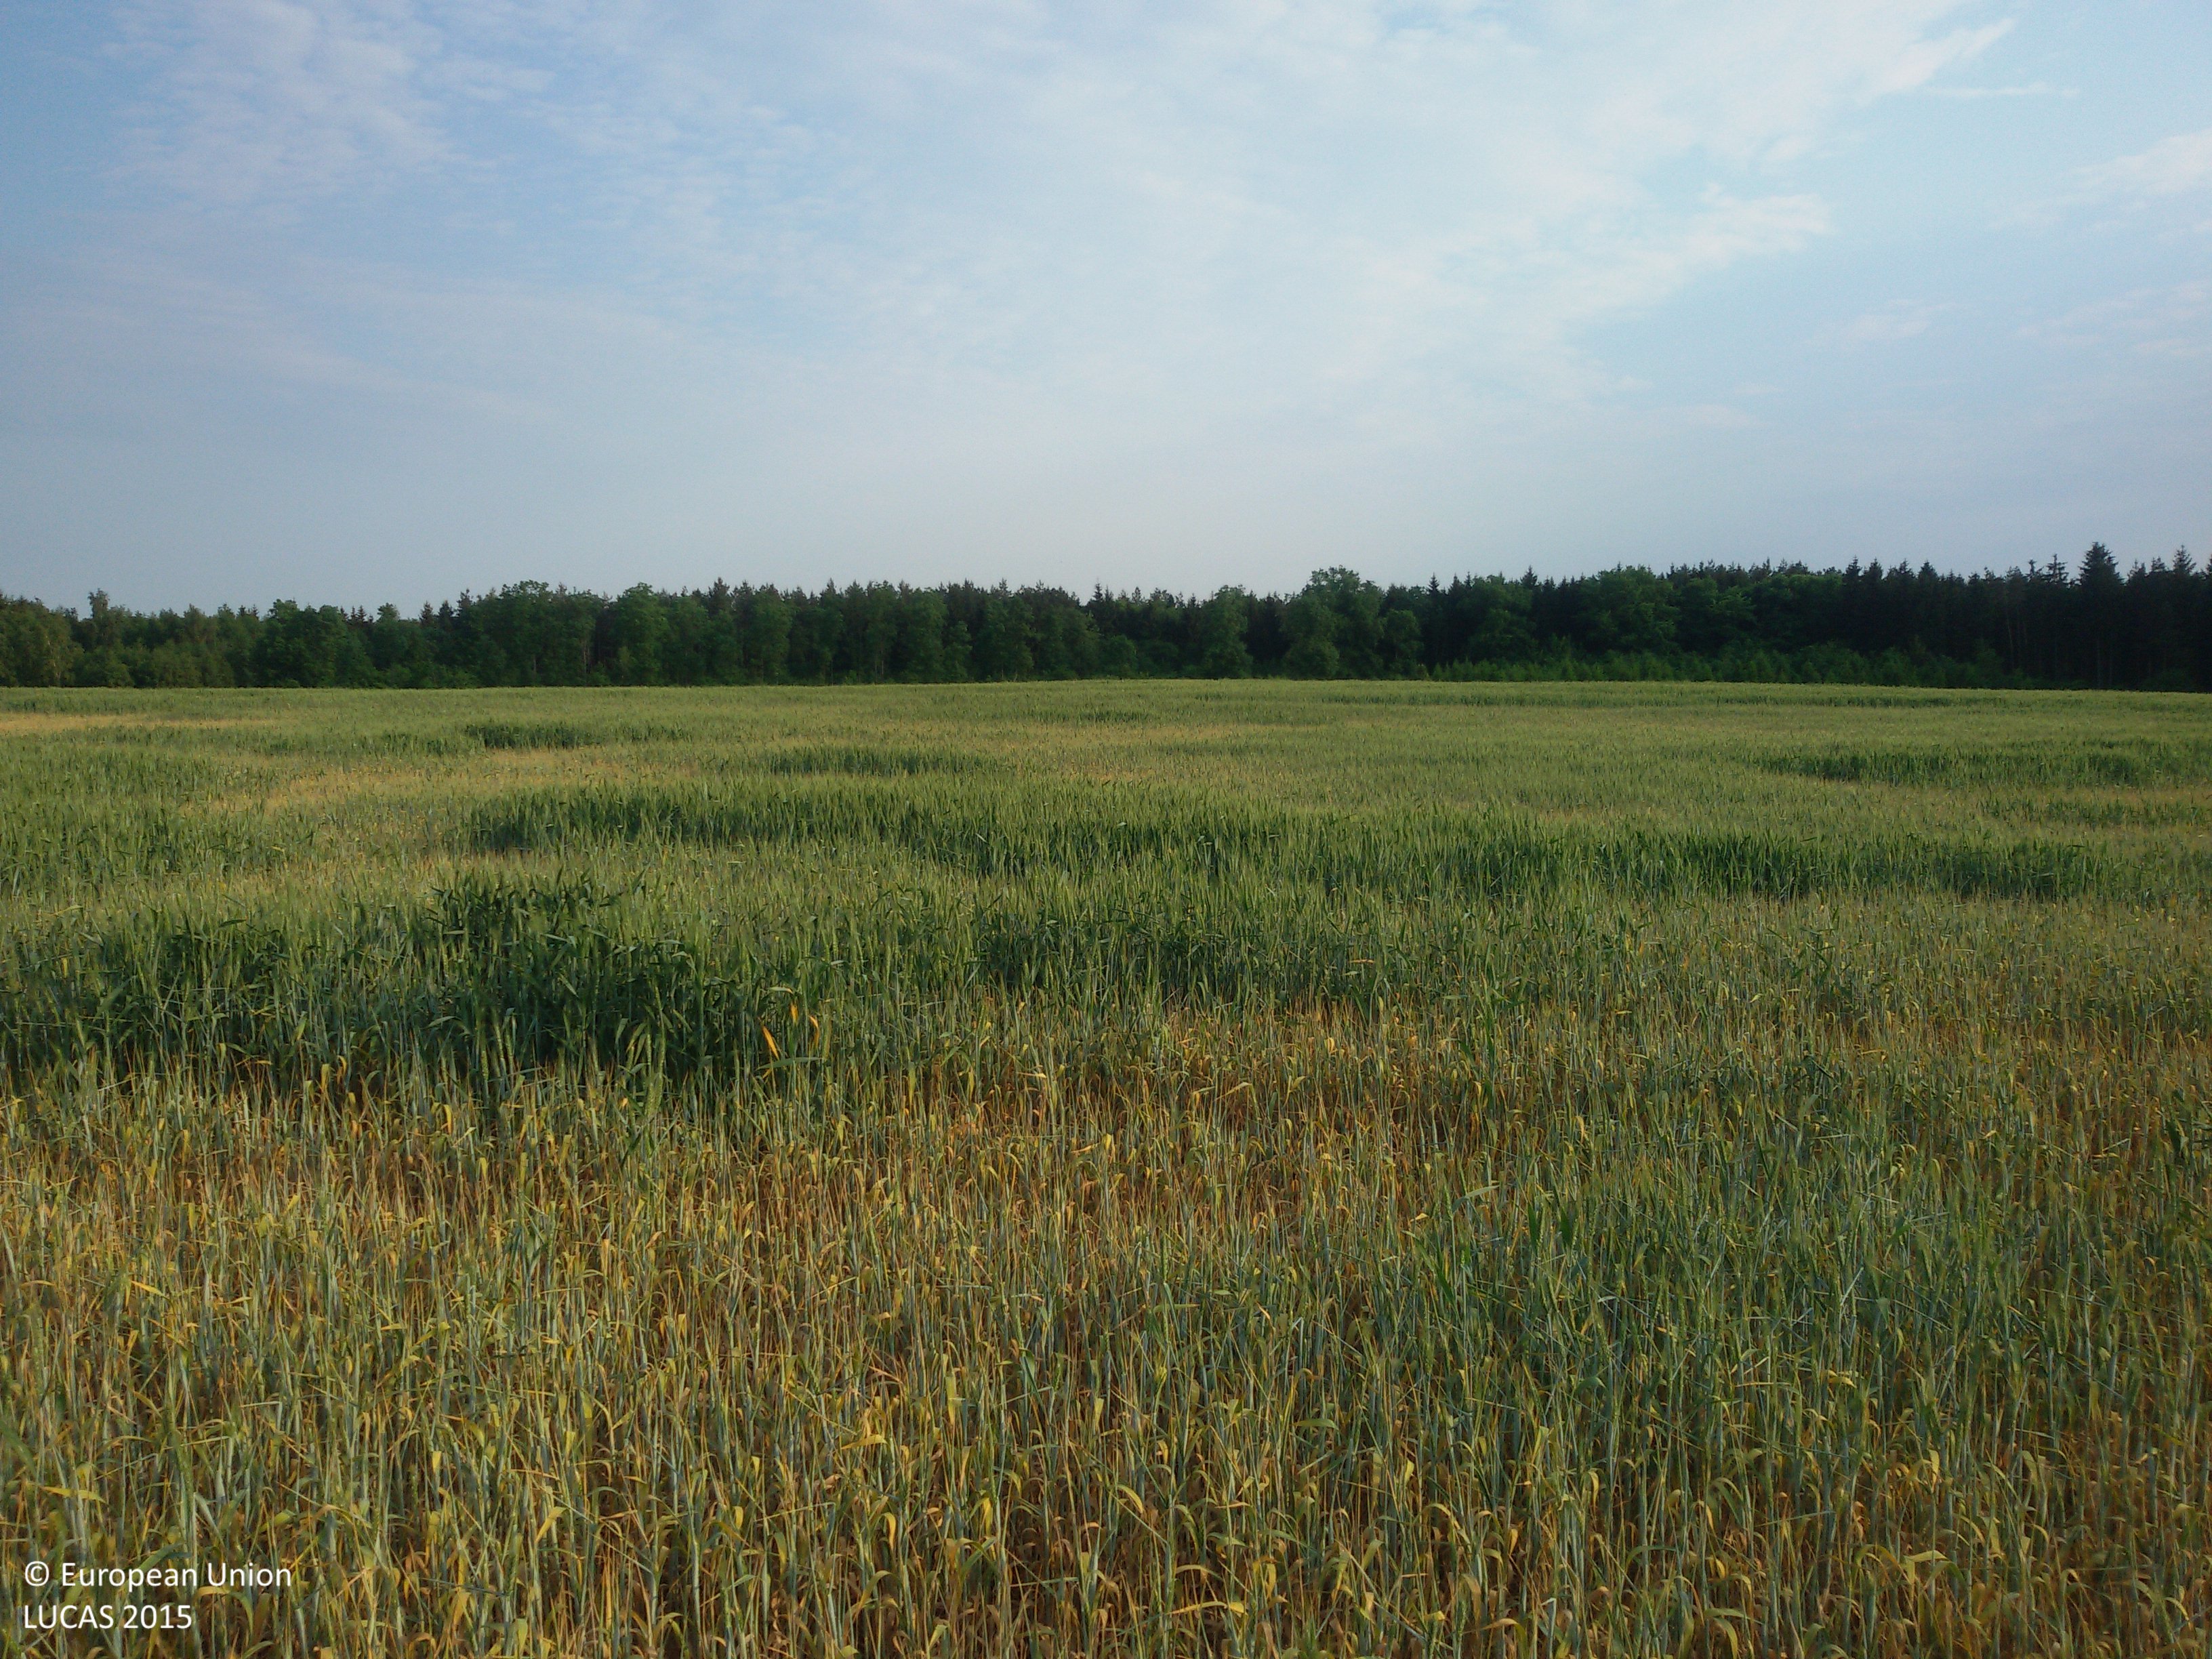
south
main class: Cropland
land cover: Common wheat
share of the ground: > 75 %
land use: Agriculture (excluding fallow land and kitchen gardens)
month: June
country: PL
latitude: 53.2328
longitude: 17.6383
